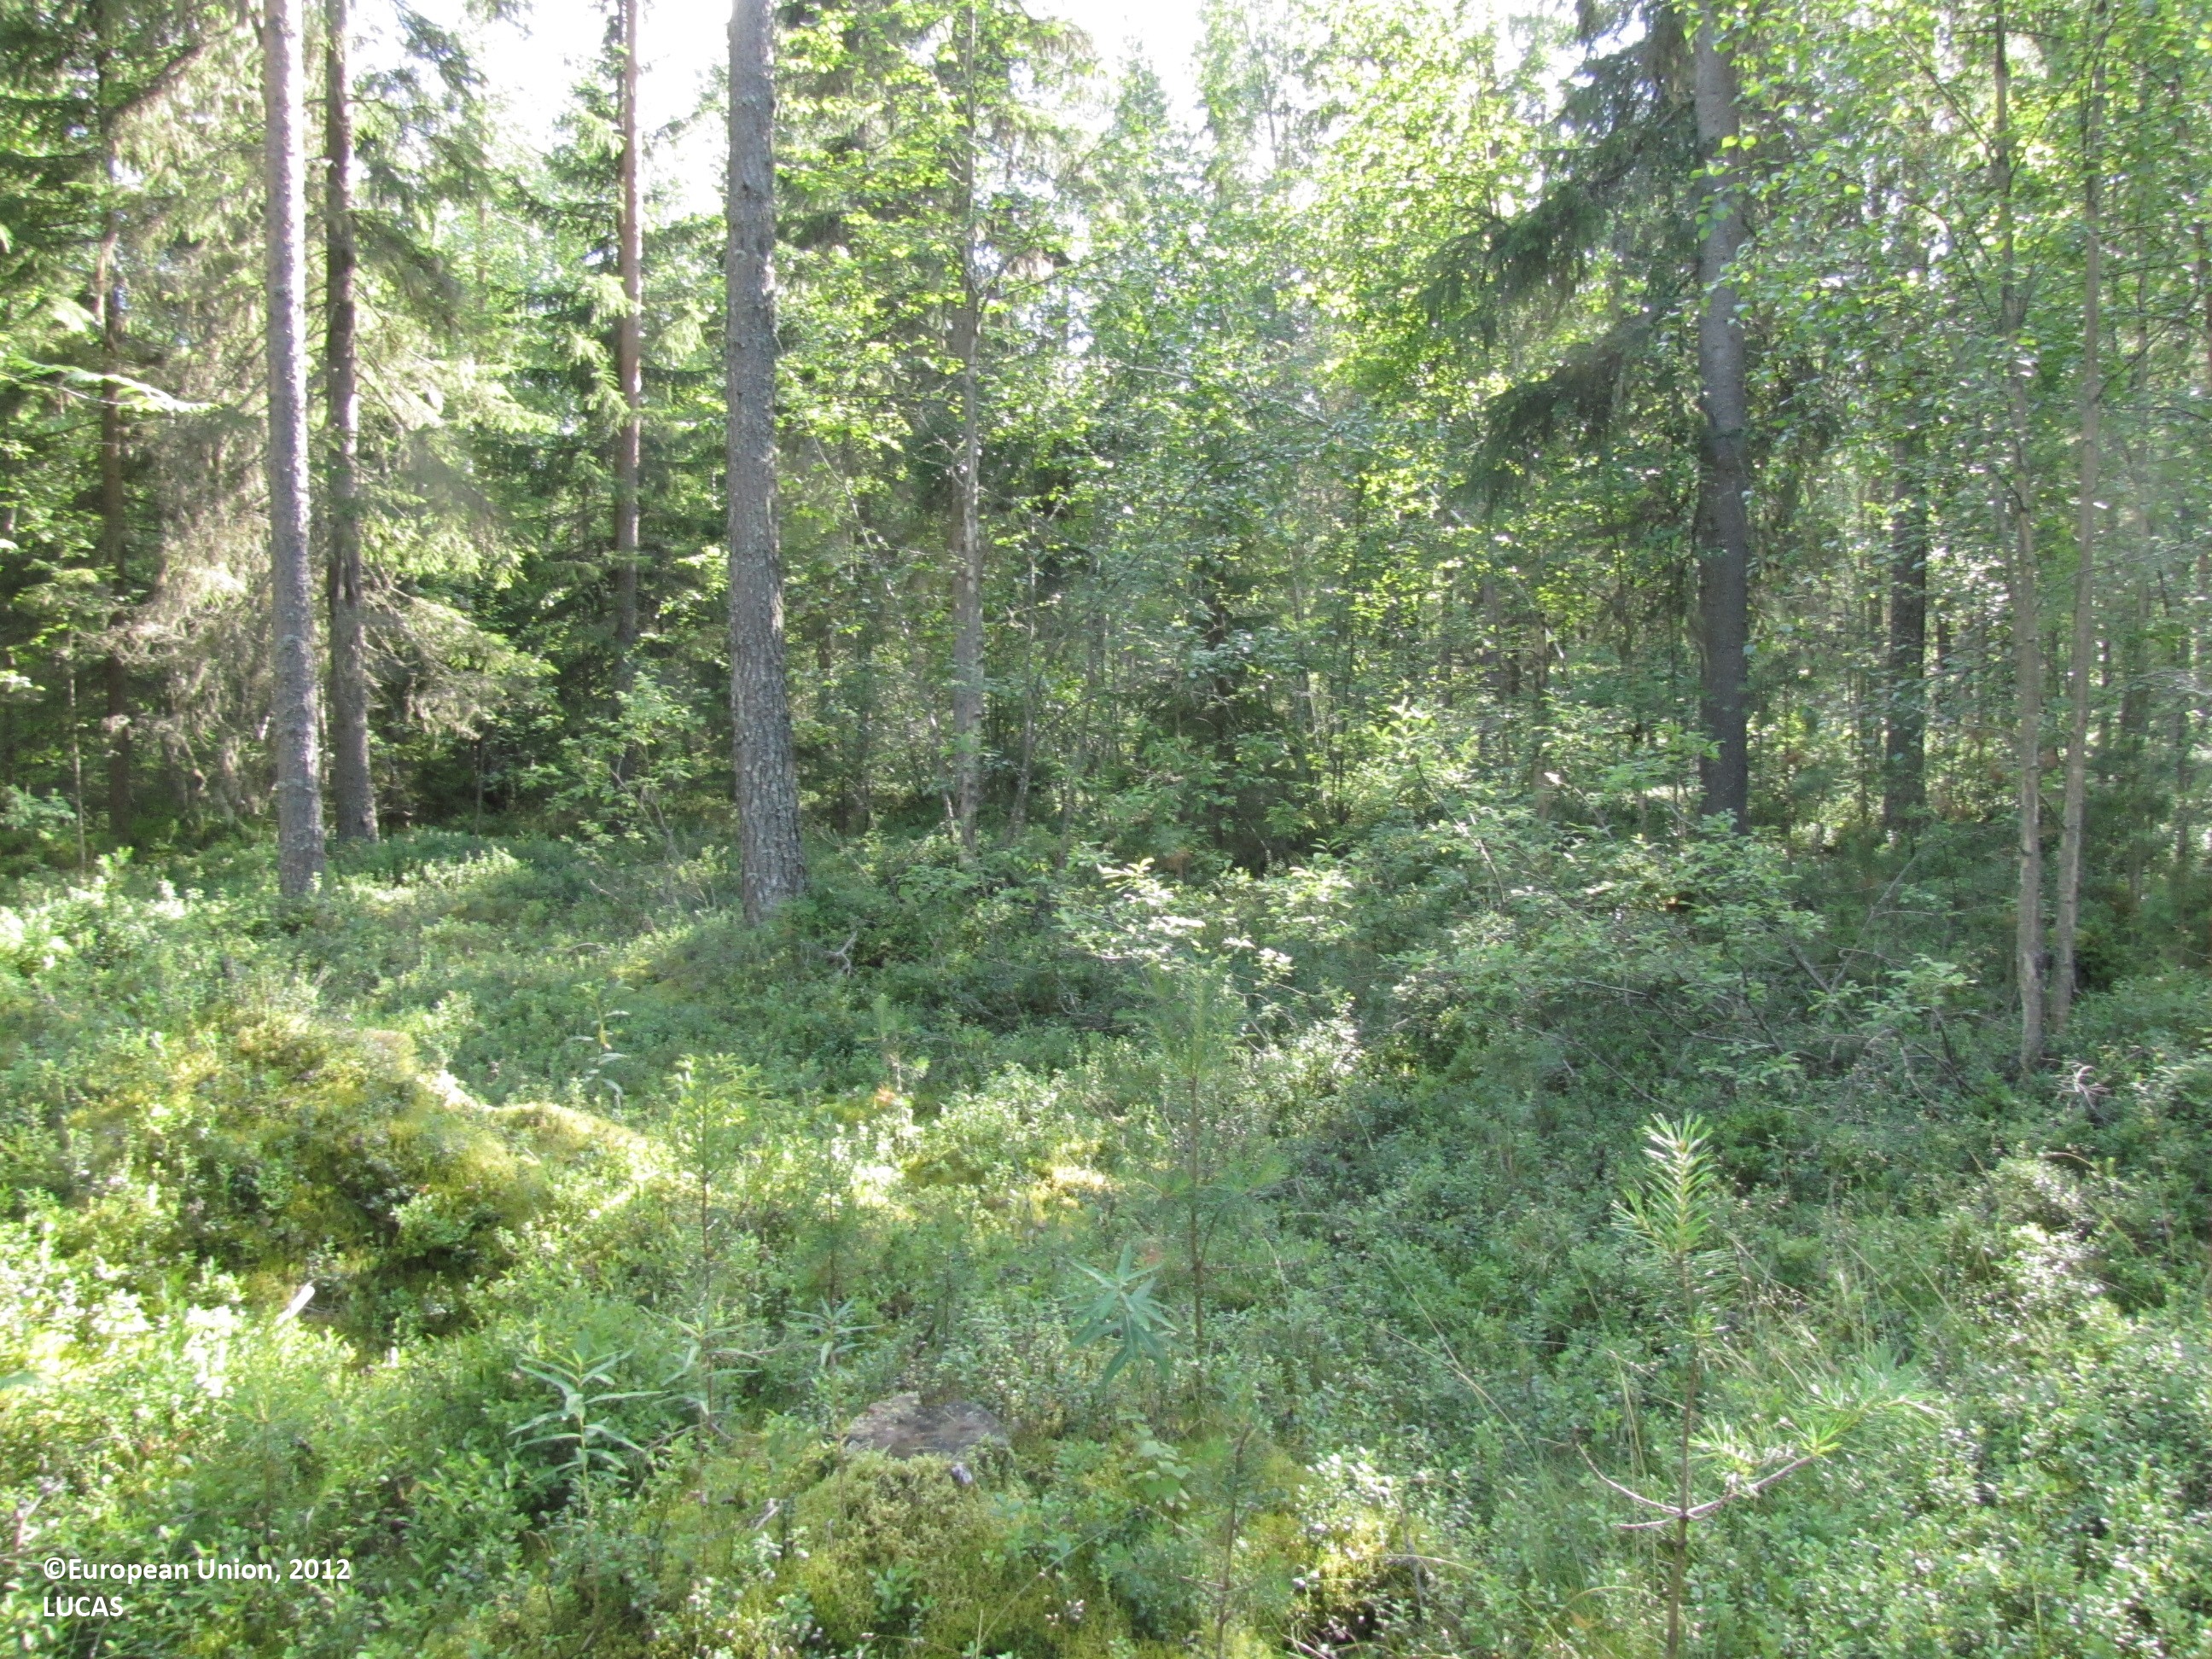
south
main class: Woodland
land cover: Spruce dominated coniferous woodland
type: boreal forest
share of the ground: 50 - 75 %
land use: Forestry
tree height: > 5 m
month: July
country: FI
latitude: 62.1868
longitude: 23.2682
